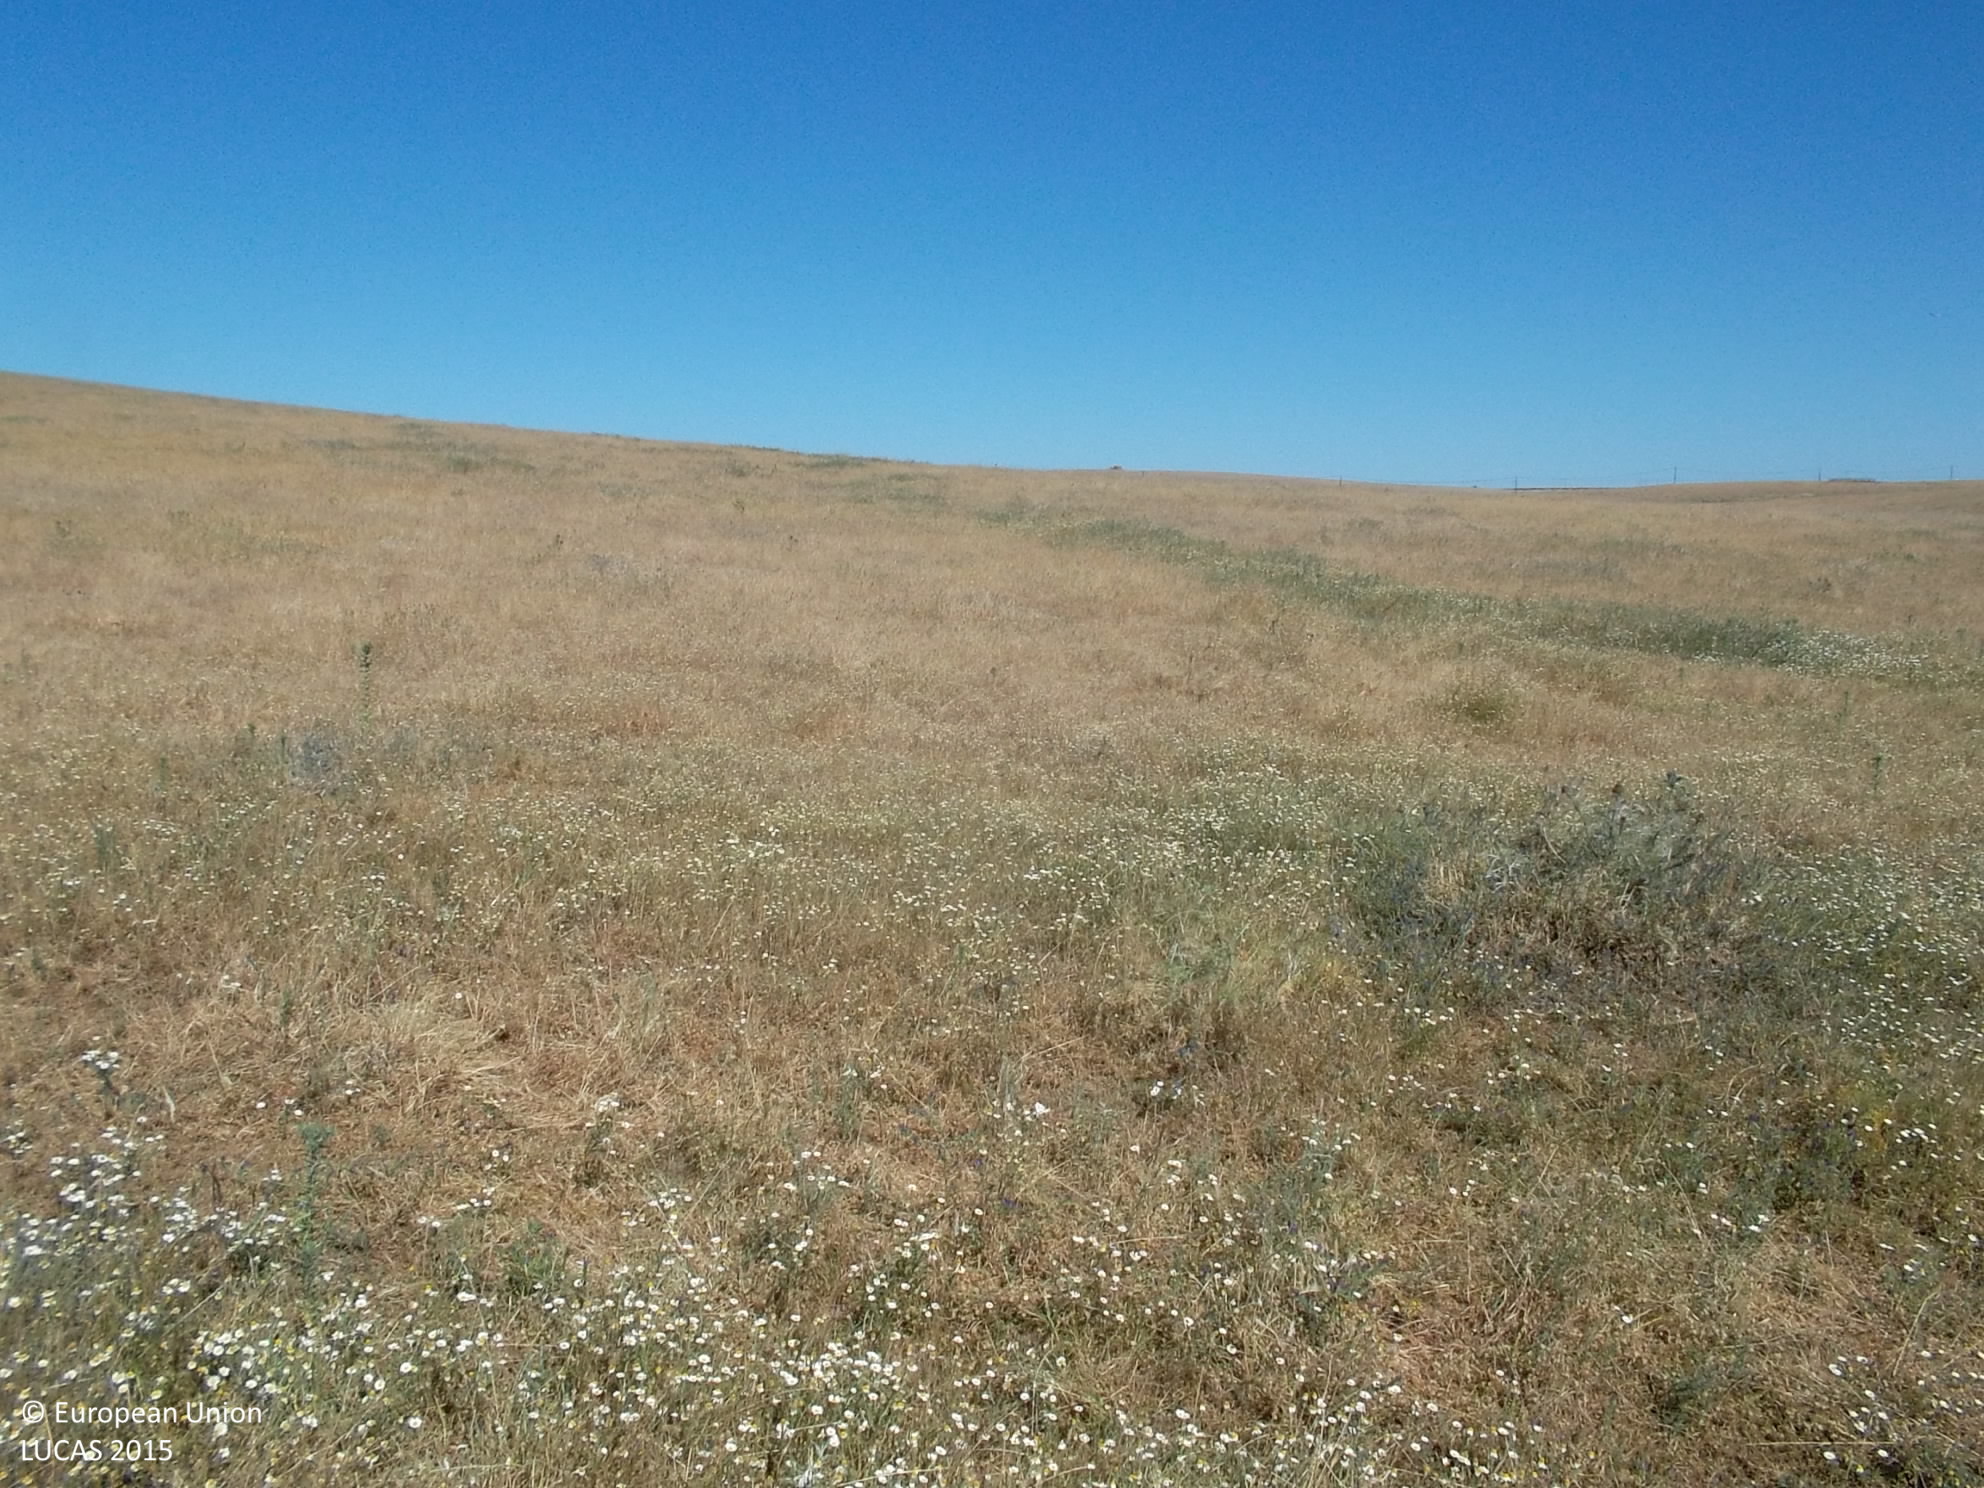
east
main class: Grassland
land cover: Grassland without tree/shrub cover
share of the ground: > 75 %
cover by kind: herbaceous plants 100 %
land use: Agriculture (excluding fallow land and kitchen gardens)
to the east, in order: Grassland without tree/shrub cover; Rivers and streams; Grassland without tree/shrub cover
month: May
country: ES
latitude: 38.6311
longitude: -4.3917
